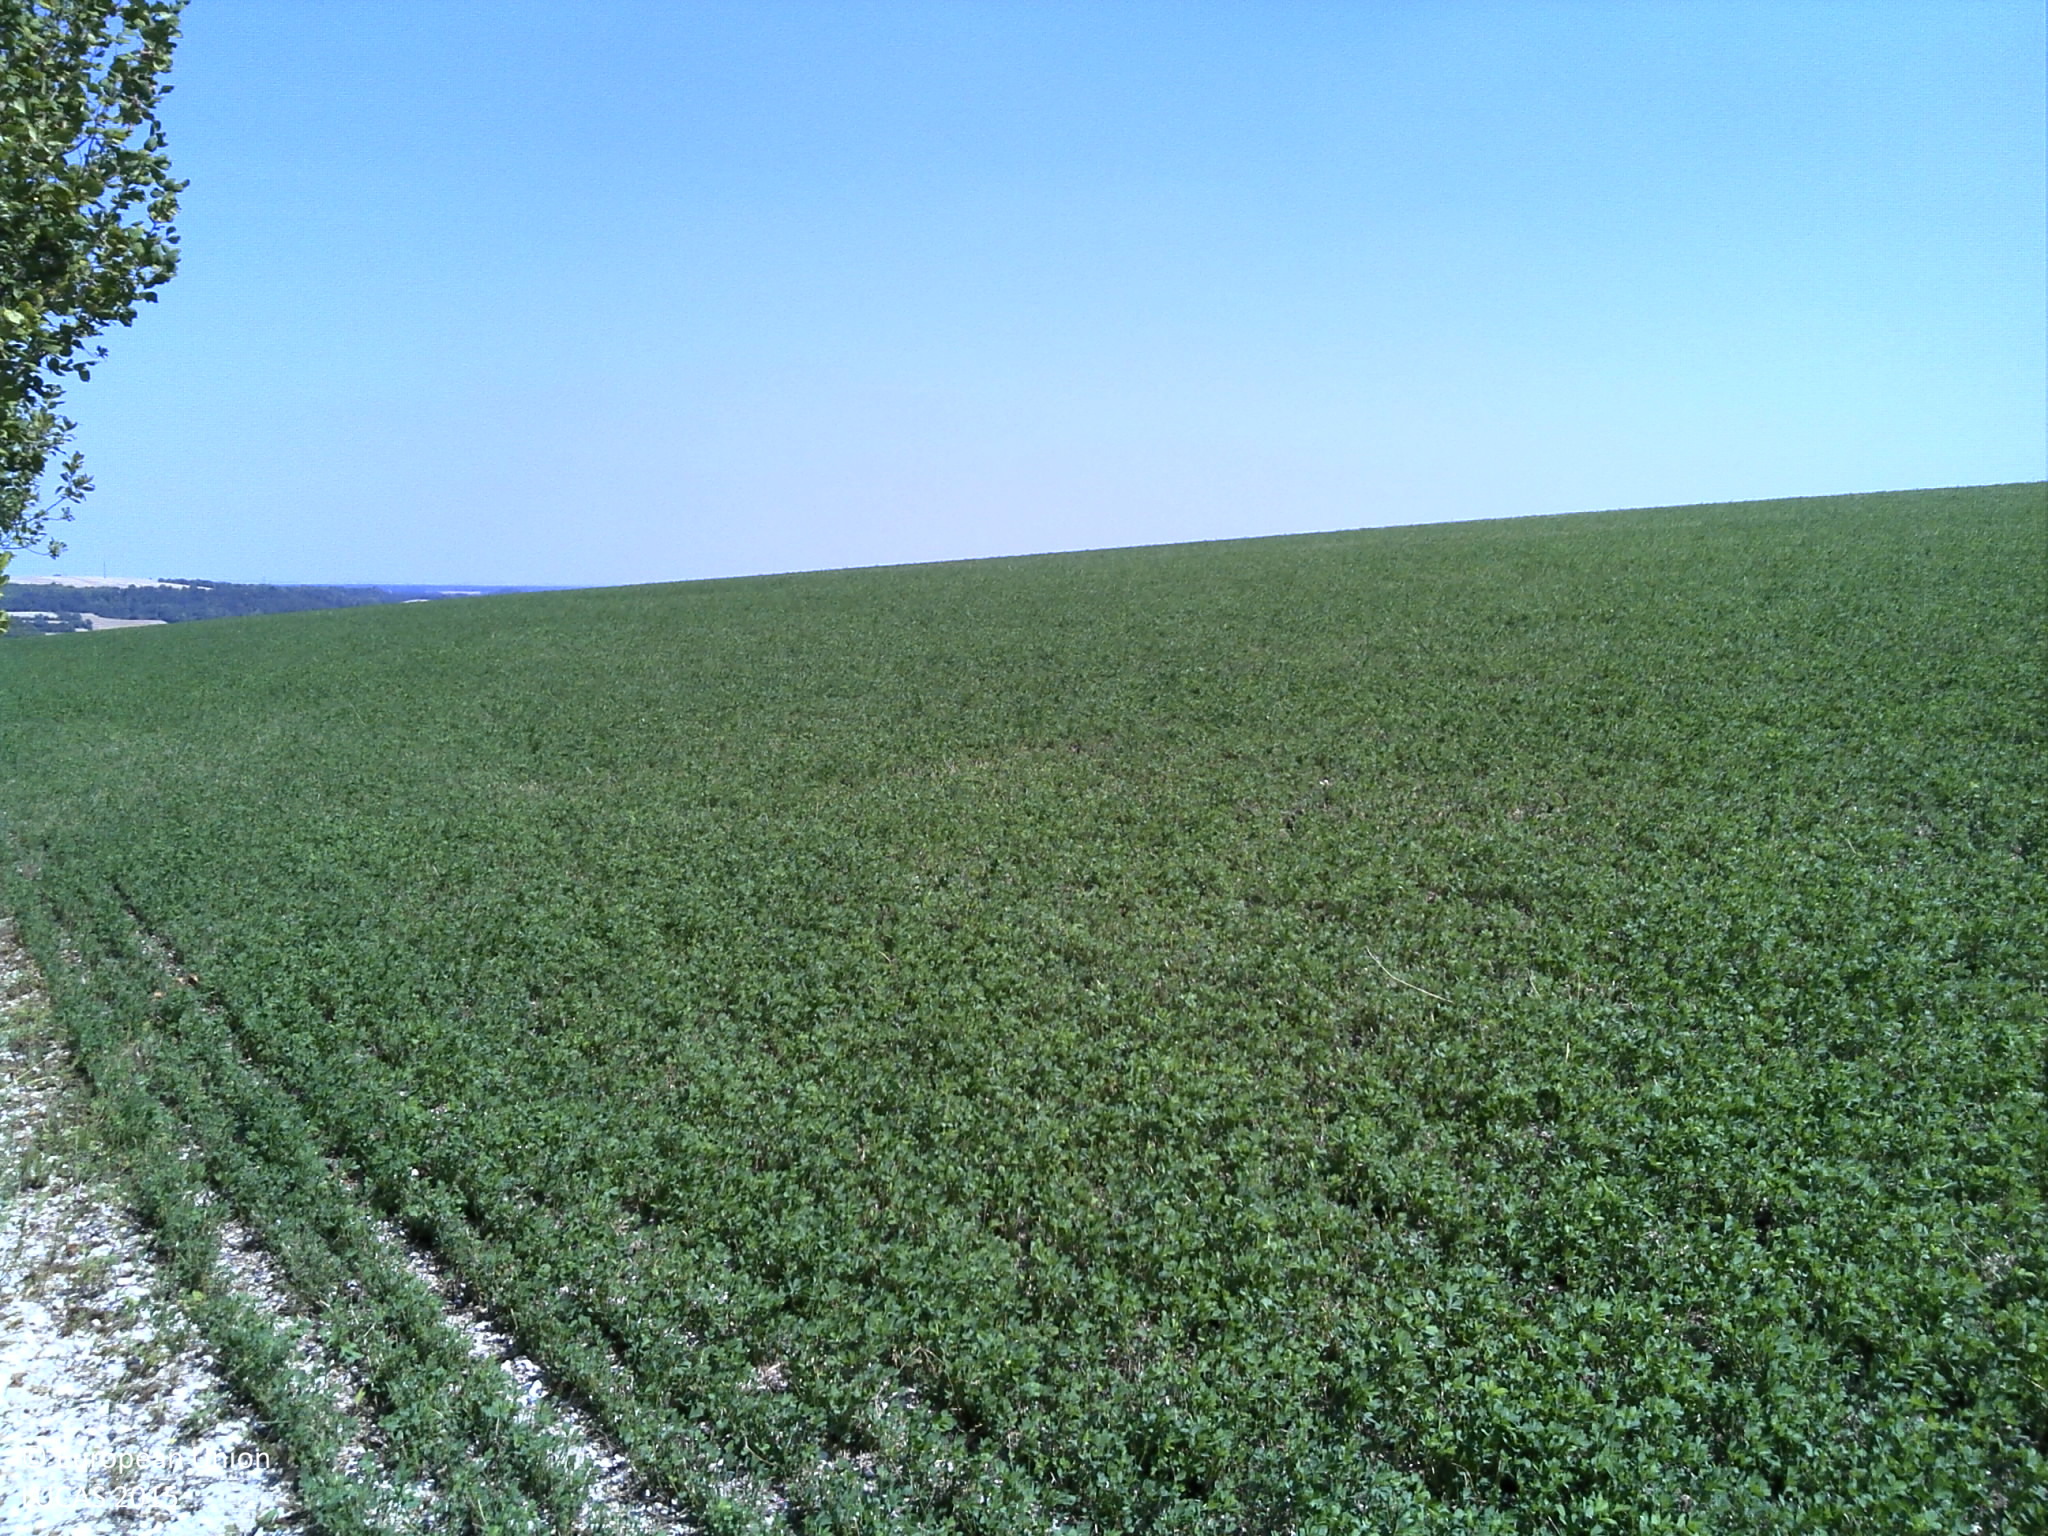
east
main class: Woodland
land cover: Spruce dominated mixed woodland
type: thermophilous deciduous forest
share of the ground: > 75 %
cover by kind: broadleaved forest trees 50 %, coniferous forest trees 25 %, herbaceous plants 20 %, shrubs 5 %
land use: Semi-natural and natural areas not in use
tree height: > 5 m
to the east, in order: Spruce dominated mixed woodland; Lucerne; Grass margins; Tracks; Grass margins; Common wheat
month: August
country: FR
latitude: 48.9096
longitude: 4.7444
